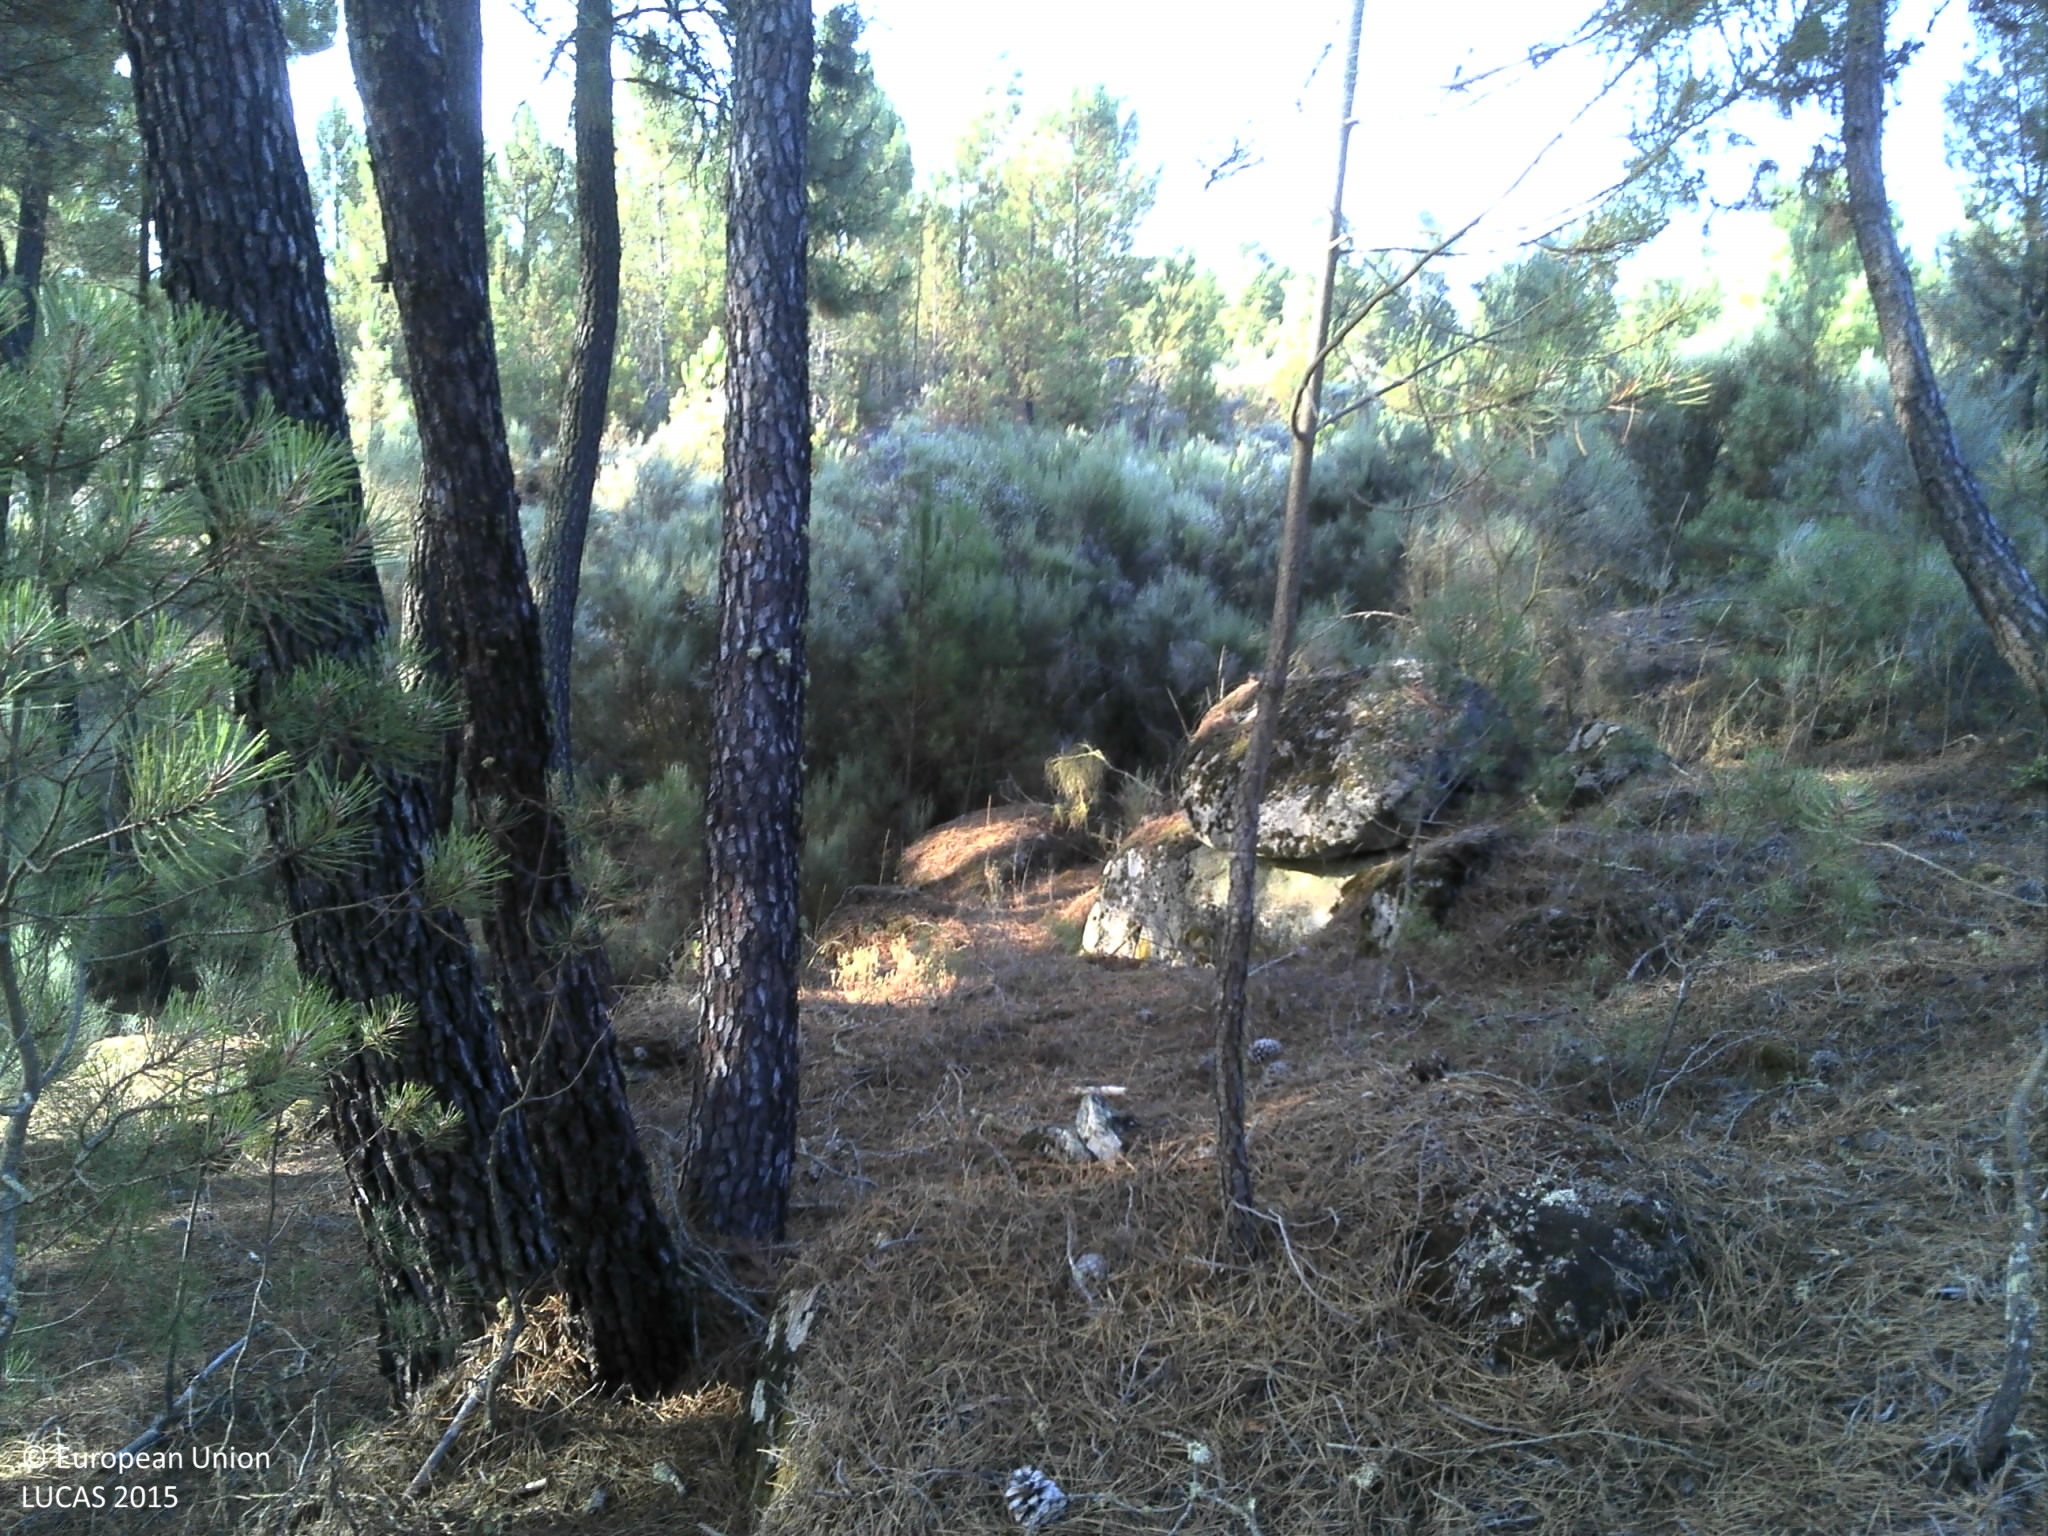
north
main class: Woodland
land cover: Pine dominated coniferous woodland
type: coniferous forest of the mediterranean region
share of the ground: 25 - 50 %
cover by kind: coniferous forest trees 30 %, shrubs 30 %, unconsolidated bare surface 30 %, consolidated bare surface 10 %
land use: Forestry
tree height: > 5 m
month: July
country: PT
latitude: 40.9332
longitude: -7.4933
